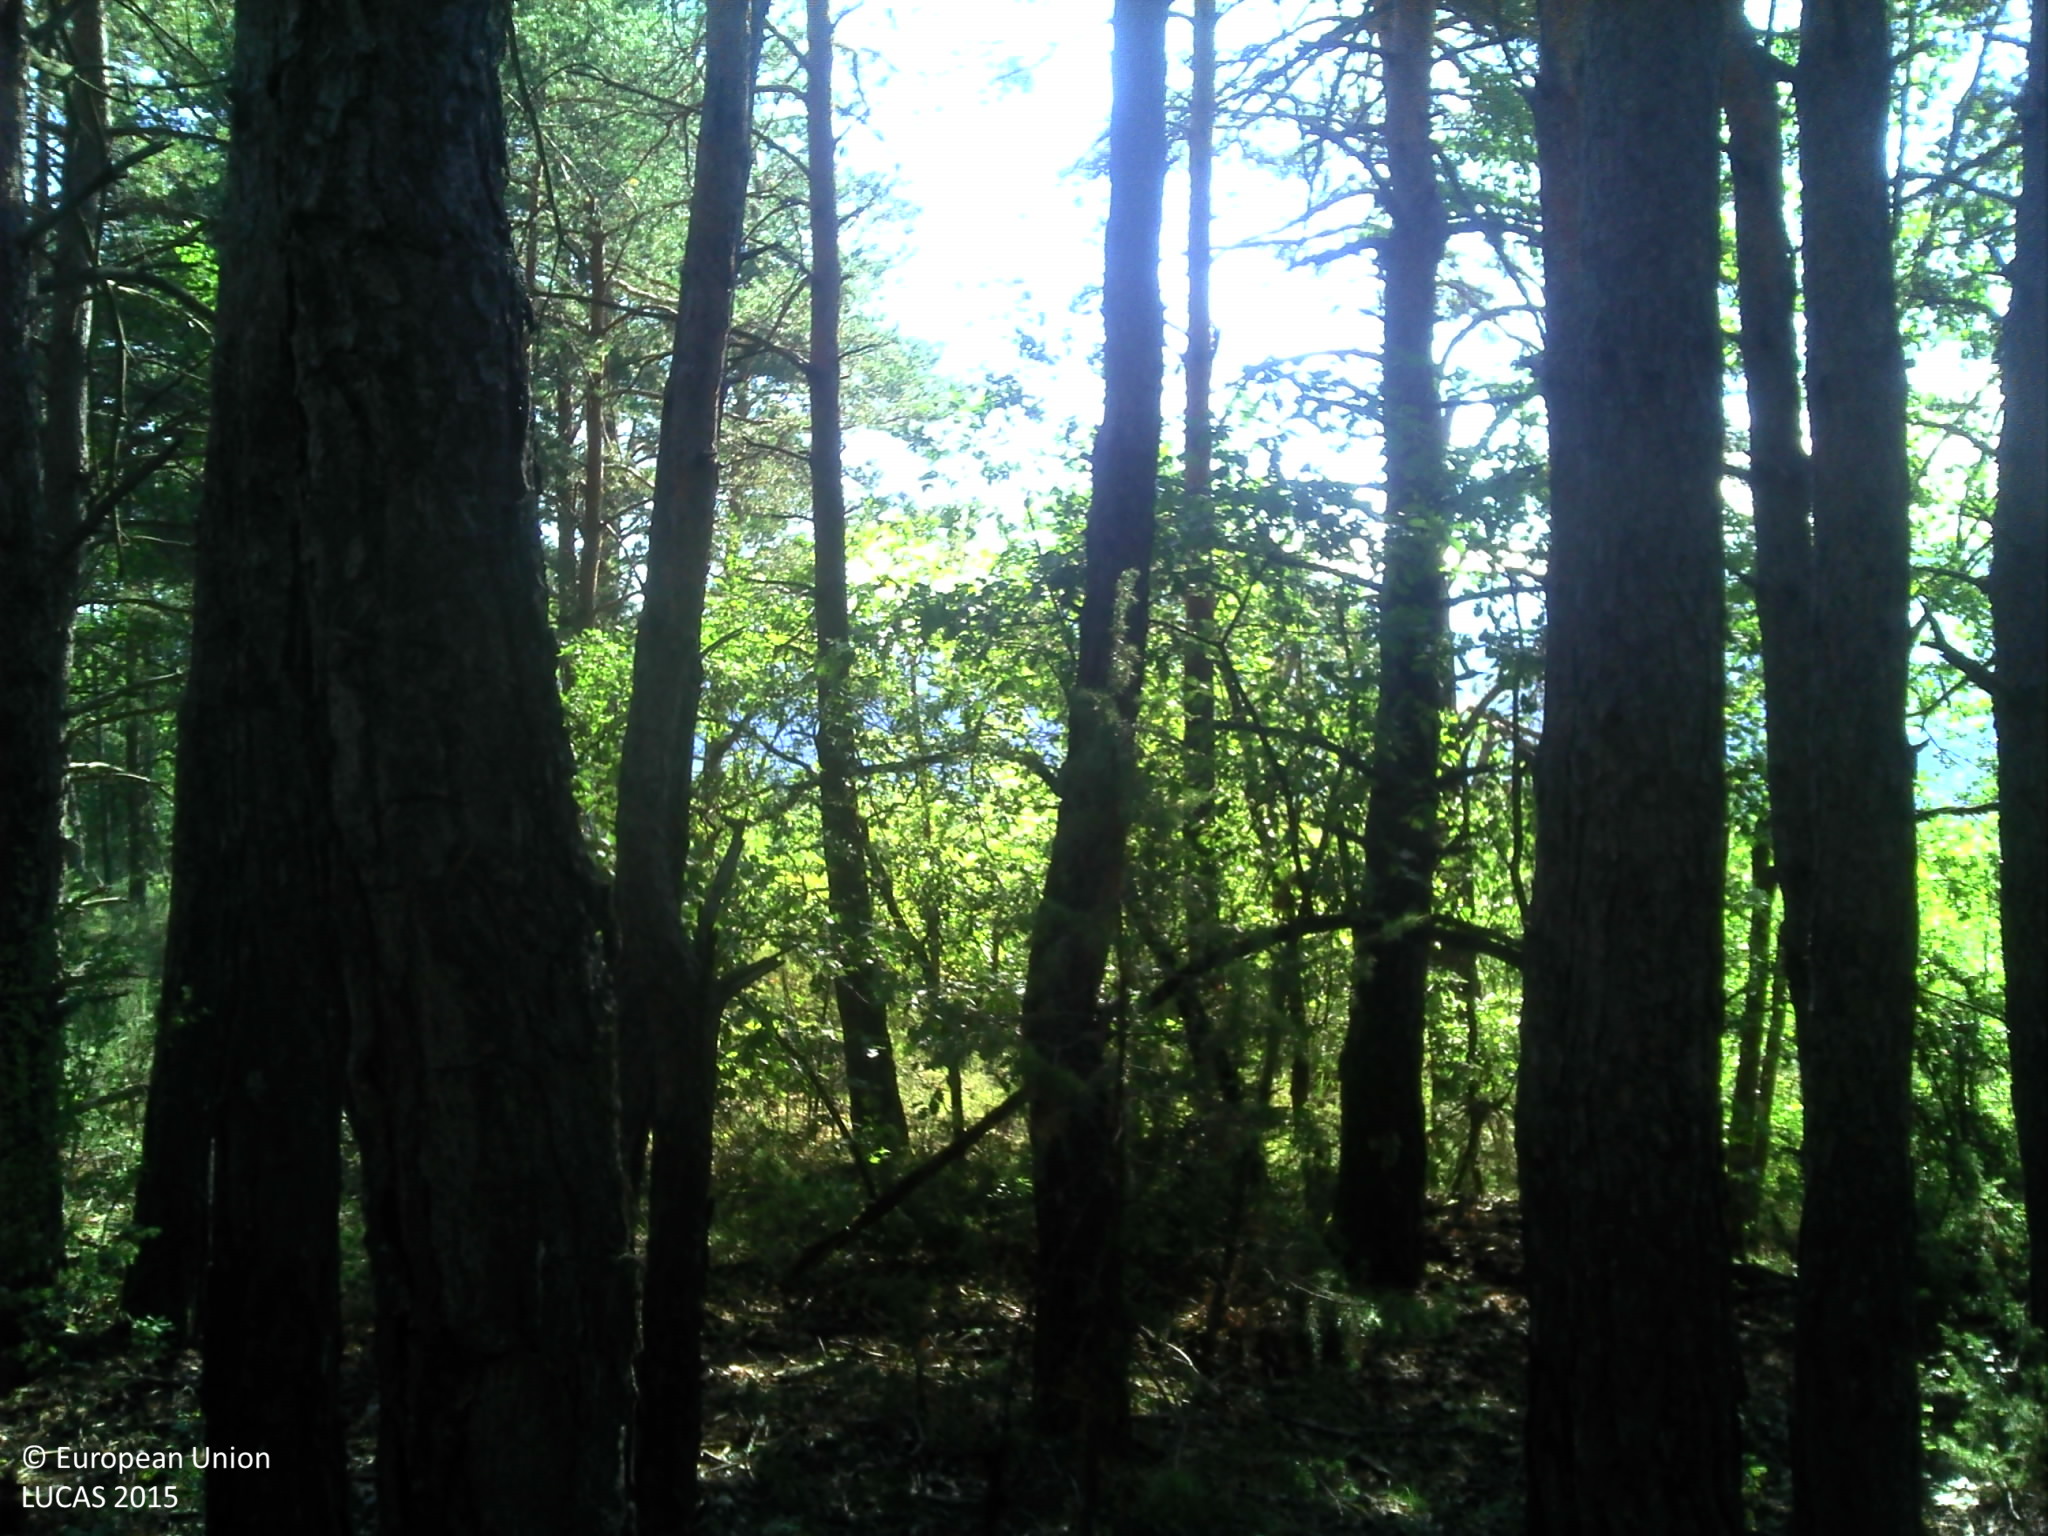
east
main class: Woodland
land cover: Pine dominated mixed woodland
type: alpine coniferous forest
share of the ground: > 75 %
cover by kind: coniferous forest trees 40 %, broadleaved forest trees 20 %, shrubs 20 %, herbaceous plants 20 %
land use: Forestry
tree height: > 5 m
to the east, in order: Pine dominated mixed woodland; Electric lines; Pine dominated mixed woodland; Ditches and canals; Shrubland without tree cover; Tracks; Grass margins; Pine dominated mixed woodland; Shrubland without tree cover; Electric lines; Shrubland with sparse tree cover; Pine dominated mixed woodland; Ditches and canals; Grass margins; Lucerne; Grass margins; Lucerne
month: August
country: FR
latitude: 44.1391
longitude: 6.2698
